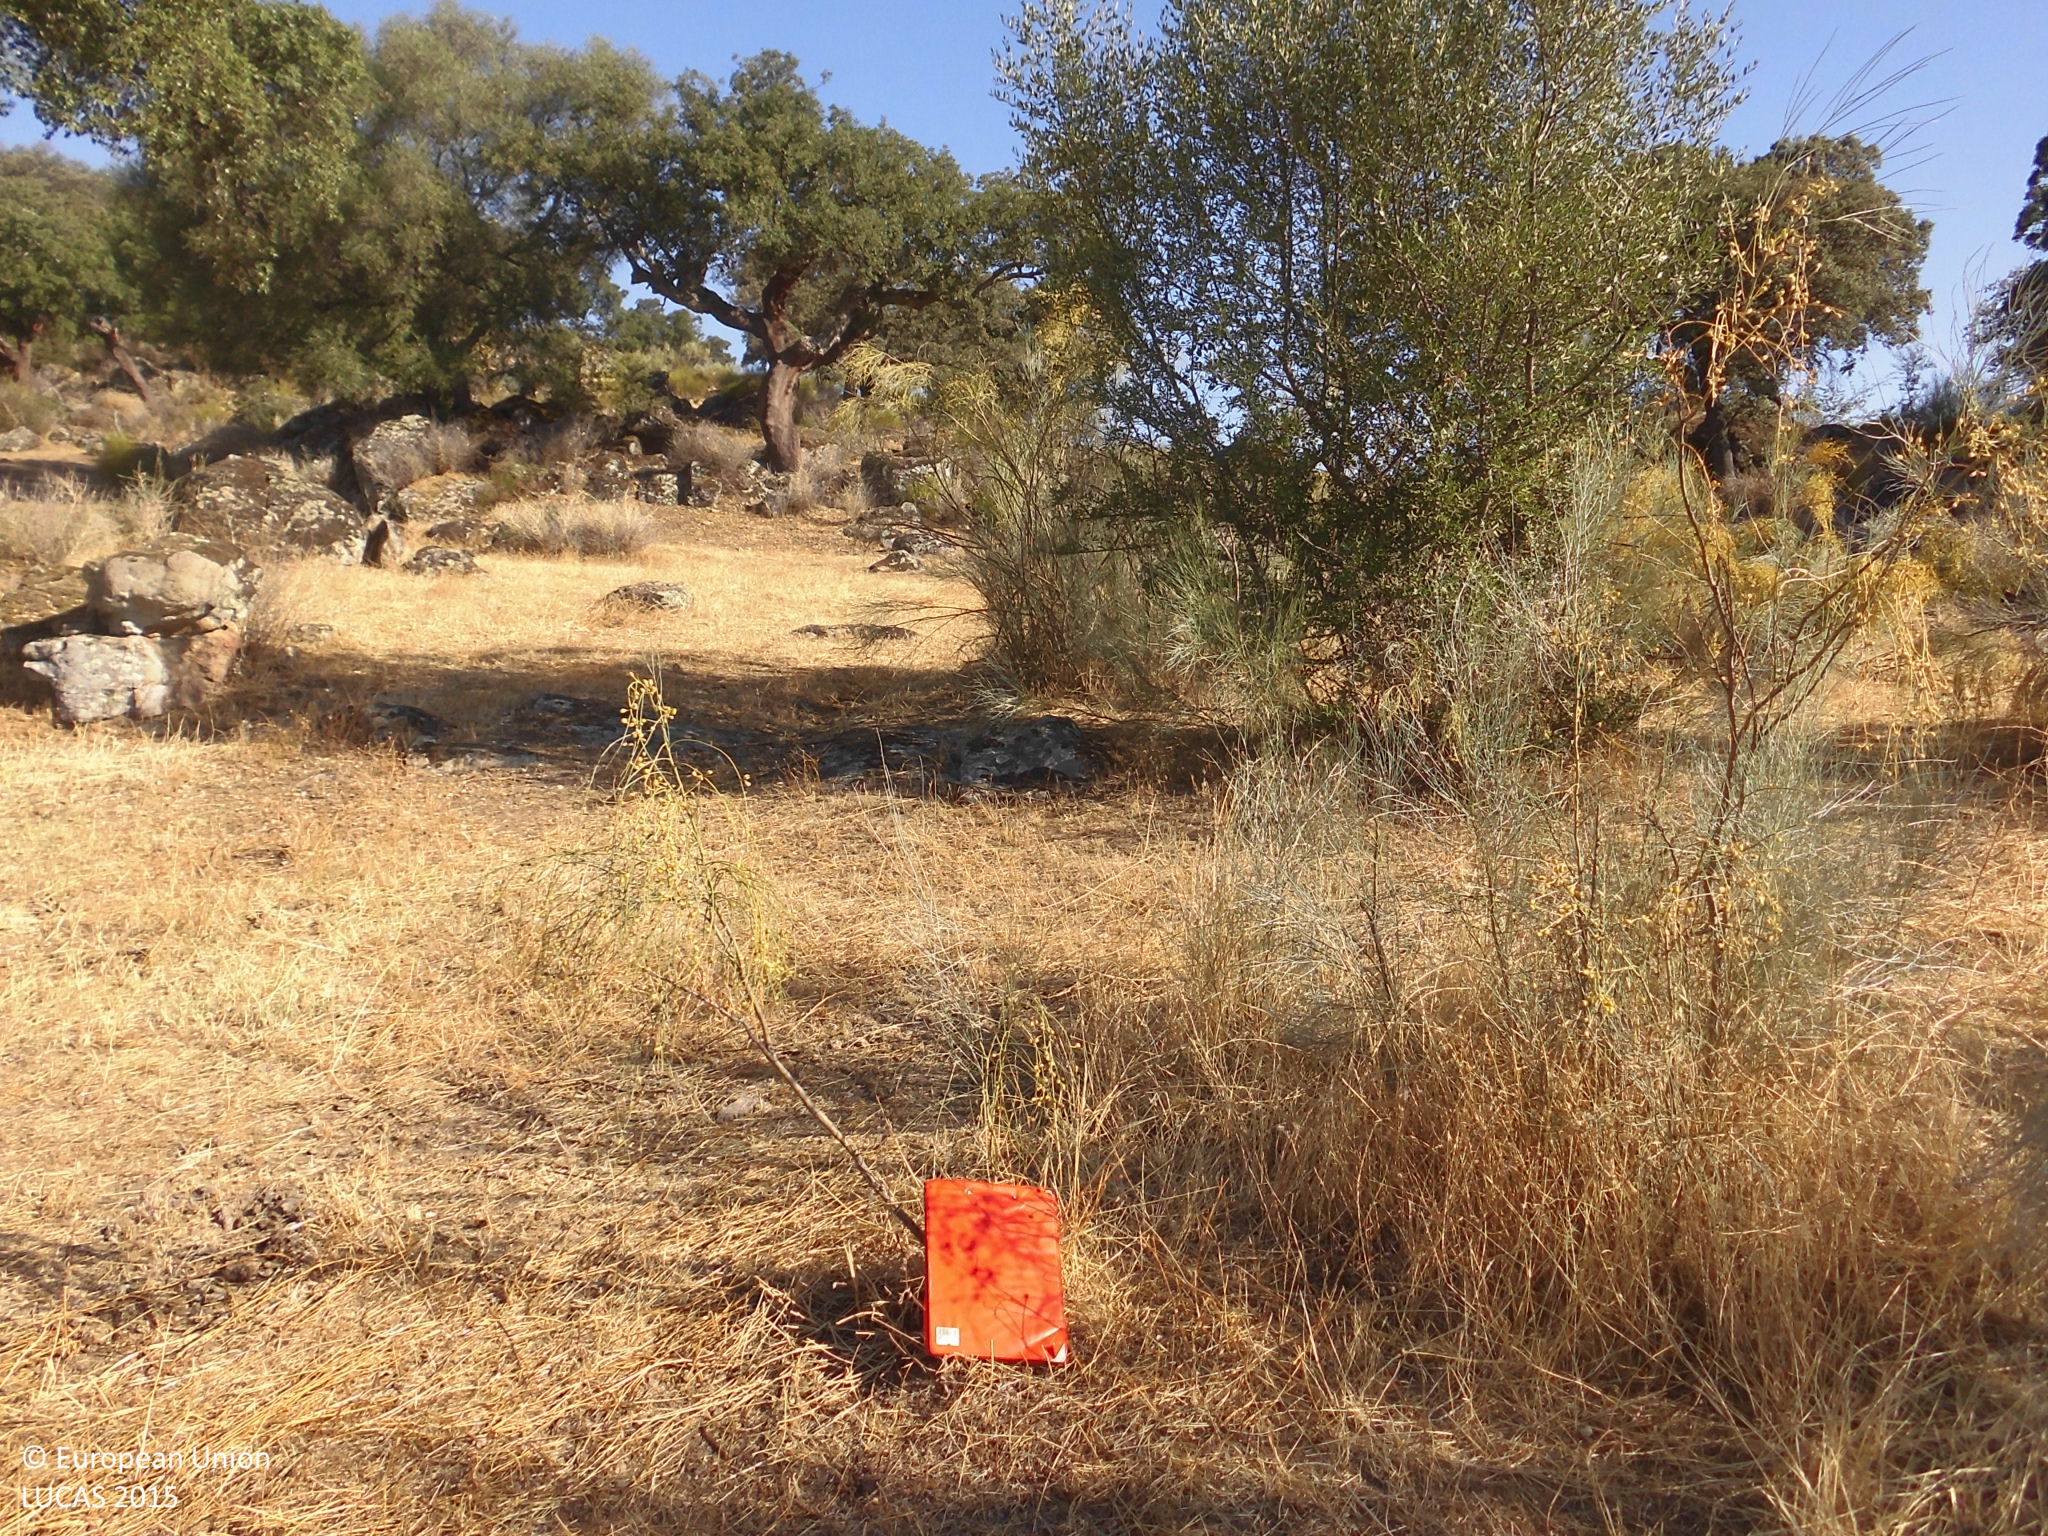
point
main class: Woodland
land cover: Broadleaved woodland
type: broadleaved evergreen forest
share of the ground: 10 - 25 %
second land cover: Shrubland without tree cover
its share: 50 - 75 %
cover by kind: shrubs 50 %, herbaceous plants 40 %, broadleaved forest trees 10 %
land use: Forestry
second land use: Agriculture (excluding fallow land and kitchen gardens)
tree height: > 5 m
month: July
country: ES
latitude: 40.0750
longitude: -6.1738
